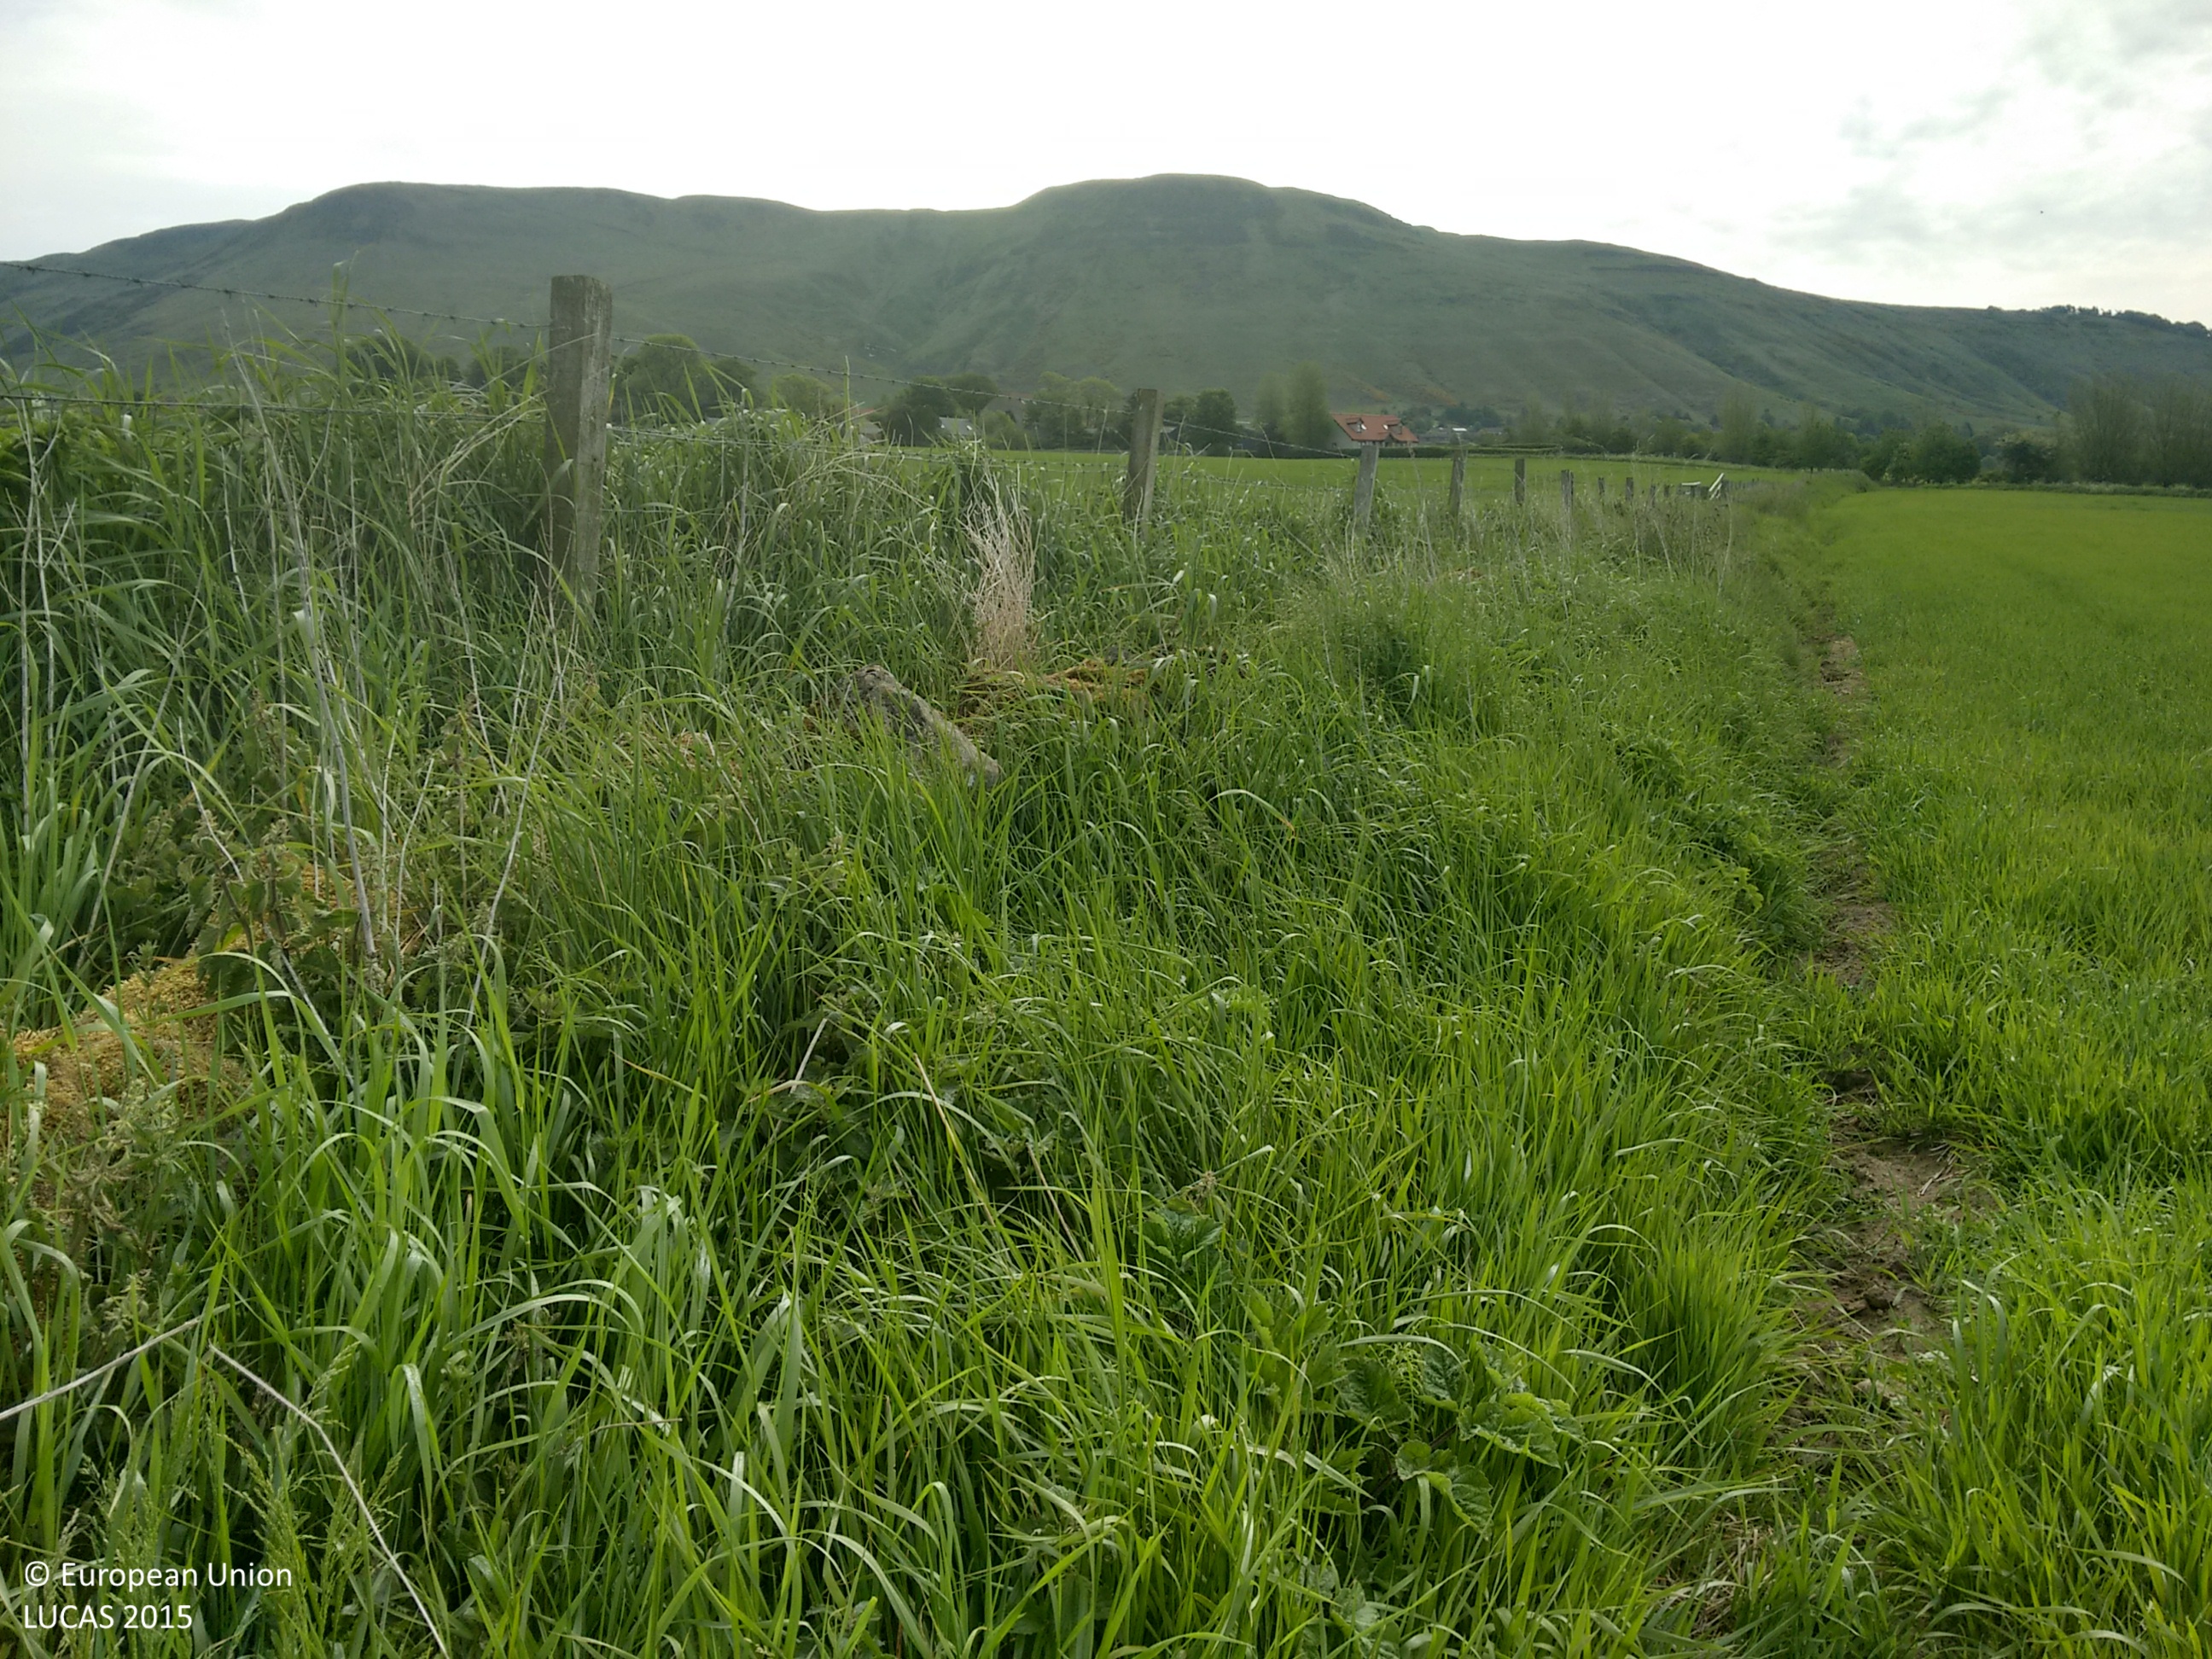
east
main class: Cropland
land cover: Barley
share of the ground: > 75 %
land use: Agriculture (excluding fallow land and kitchen gardens)
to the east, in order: Barley; Grass margins; Dry stone walls; Fences; Grass margins; Barley
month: June
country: GB
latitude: 56.2168
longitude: -3.3444
